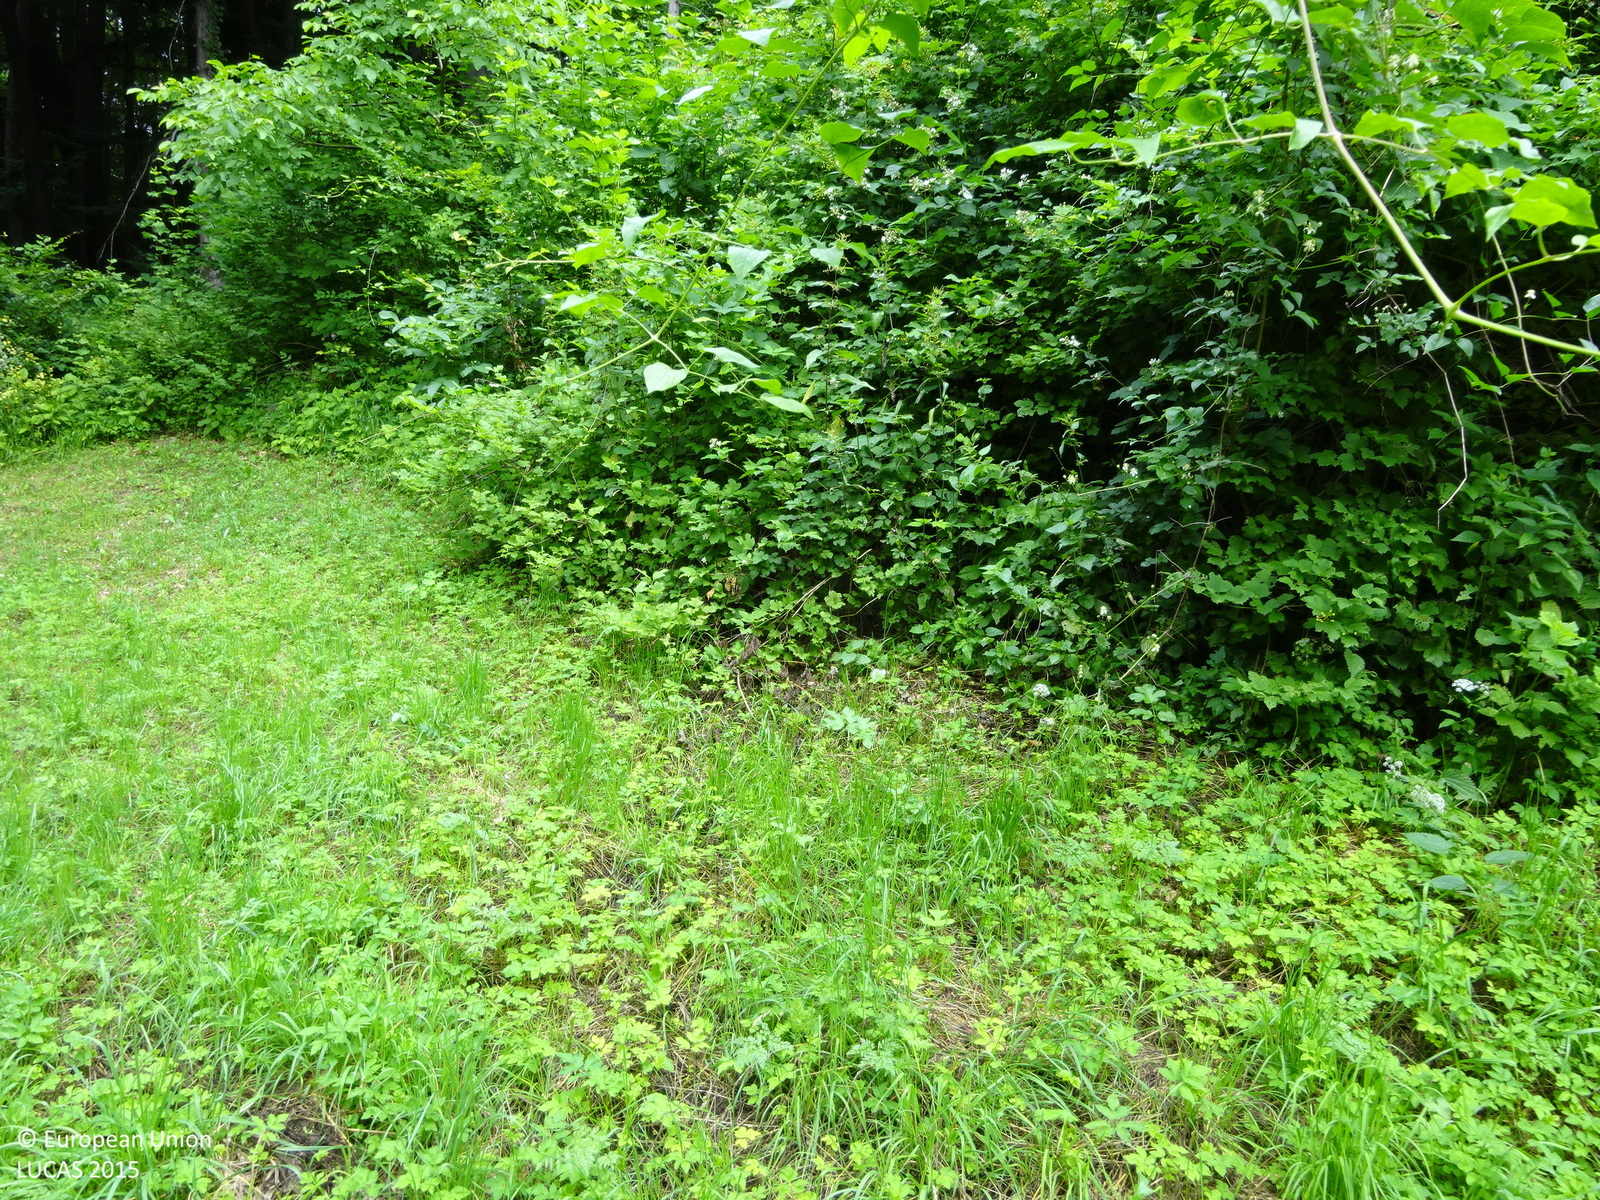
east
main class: Grassland
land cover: Grassland without tree/shrub cover
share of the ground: > 75 %
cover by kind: herbaceous plants 100 %
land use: Agriculture (excluding fallow land and kitchen gardens)
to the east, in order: Grassland without tree/shrub cover; Shrubland with sparse tree cover; Electric lines; Shrubland with sparse tree cover; Broadleaved woodland; Spruce dominated mixed woodland; Tracks; Broadleaved woodland; Tracks; Broadleaved woodland; Grassland with sparse tree/shrub cover; Grassland without tree/shrub cover; Shrubland with sparse tree cover
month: June
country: AT
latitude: 46.7174
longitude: 15.4545
